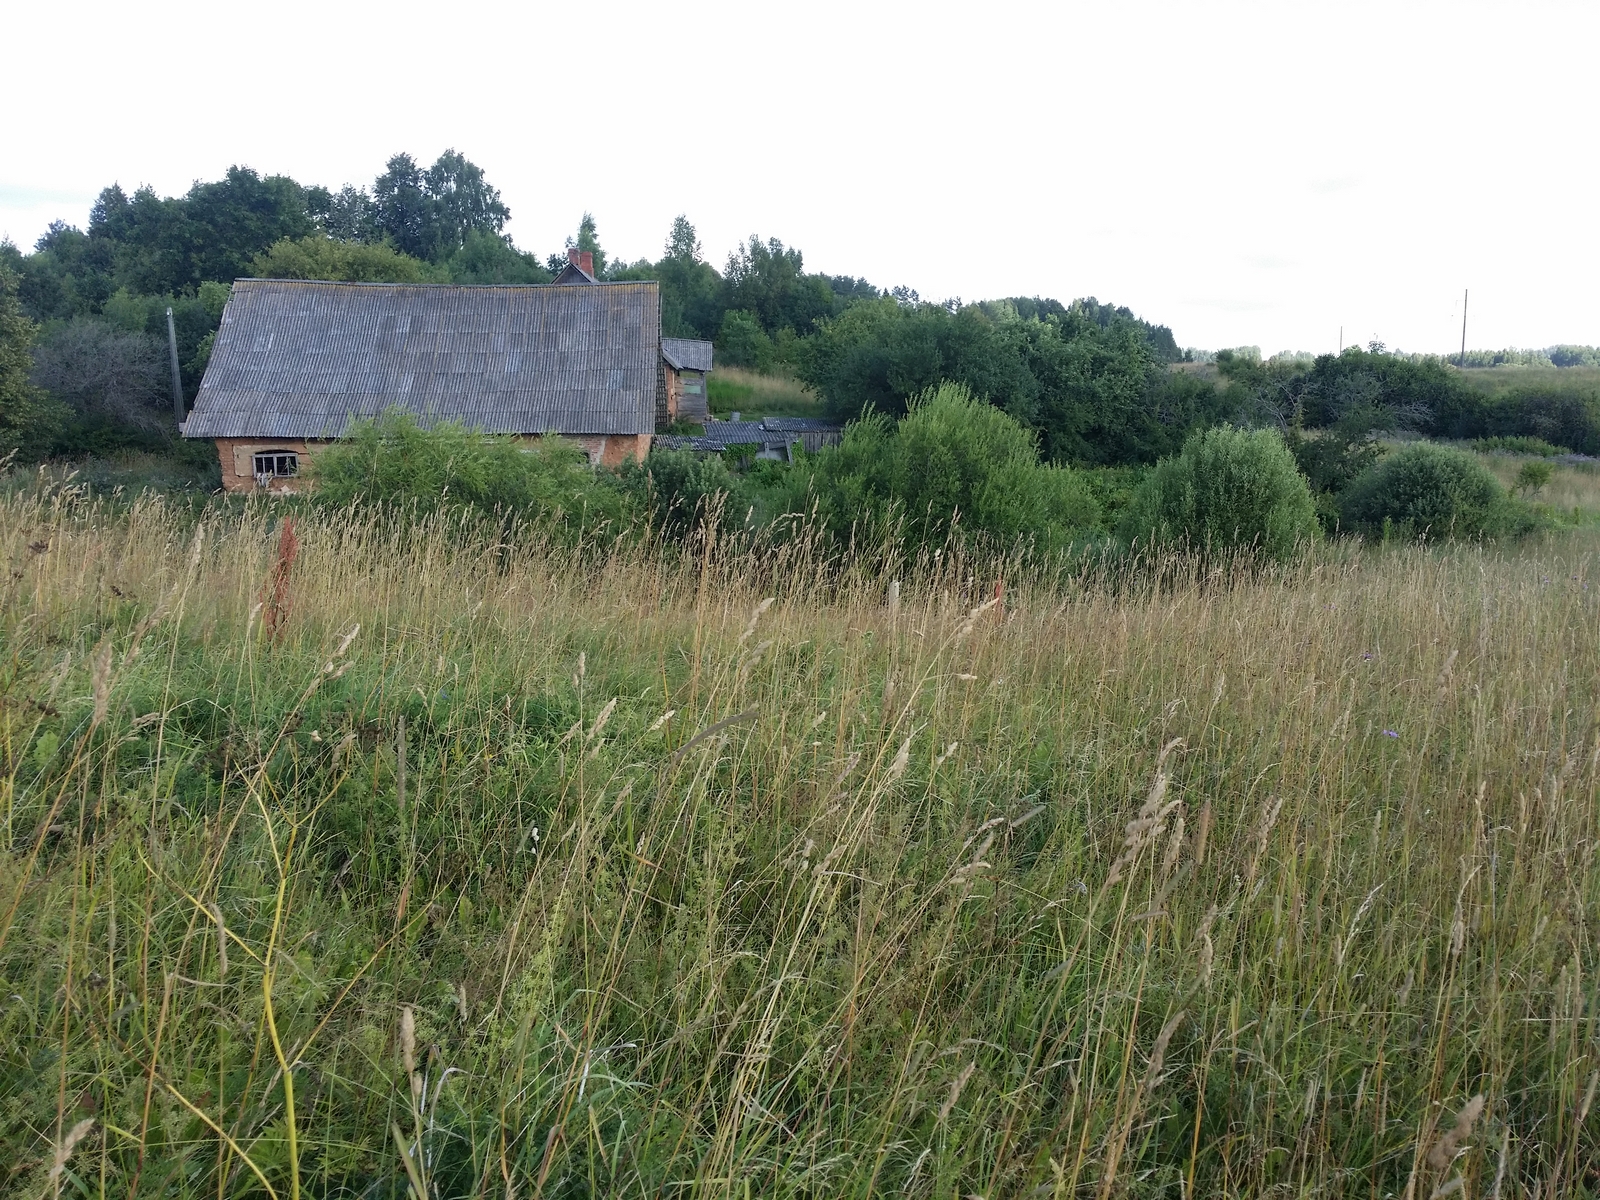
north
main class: Grassland
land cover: Grassland without tree/shrub cover
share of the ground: > 75 %
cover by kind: herbaceous plants 100 %
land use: Agriculture (excluding fallow land and kitchen gardens)
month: July
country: LV
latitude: 57.2281
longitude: 26.7660
